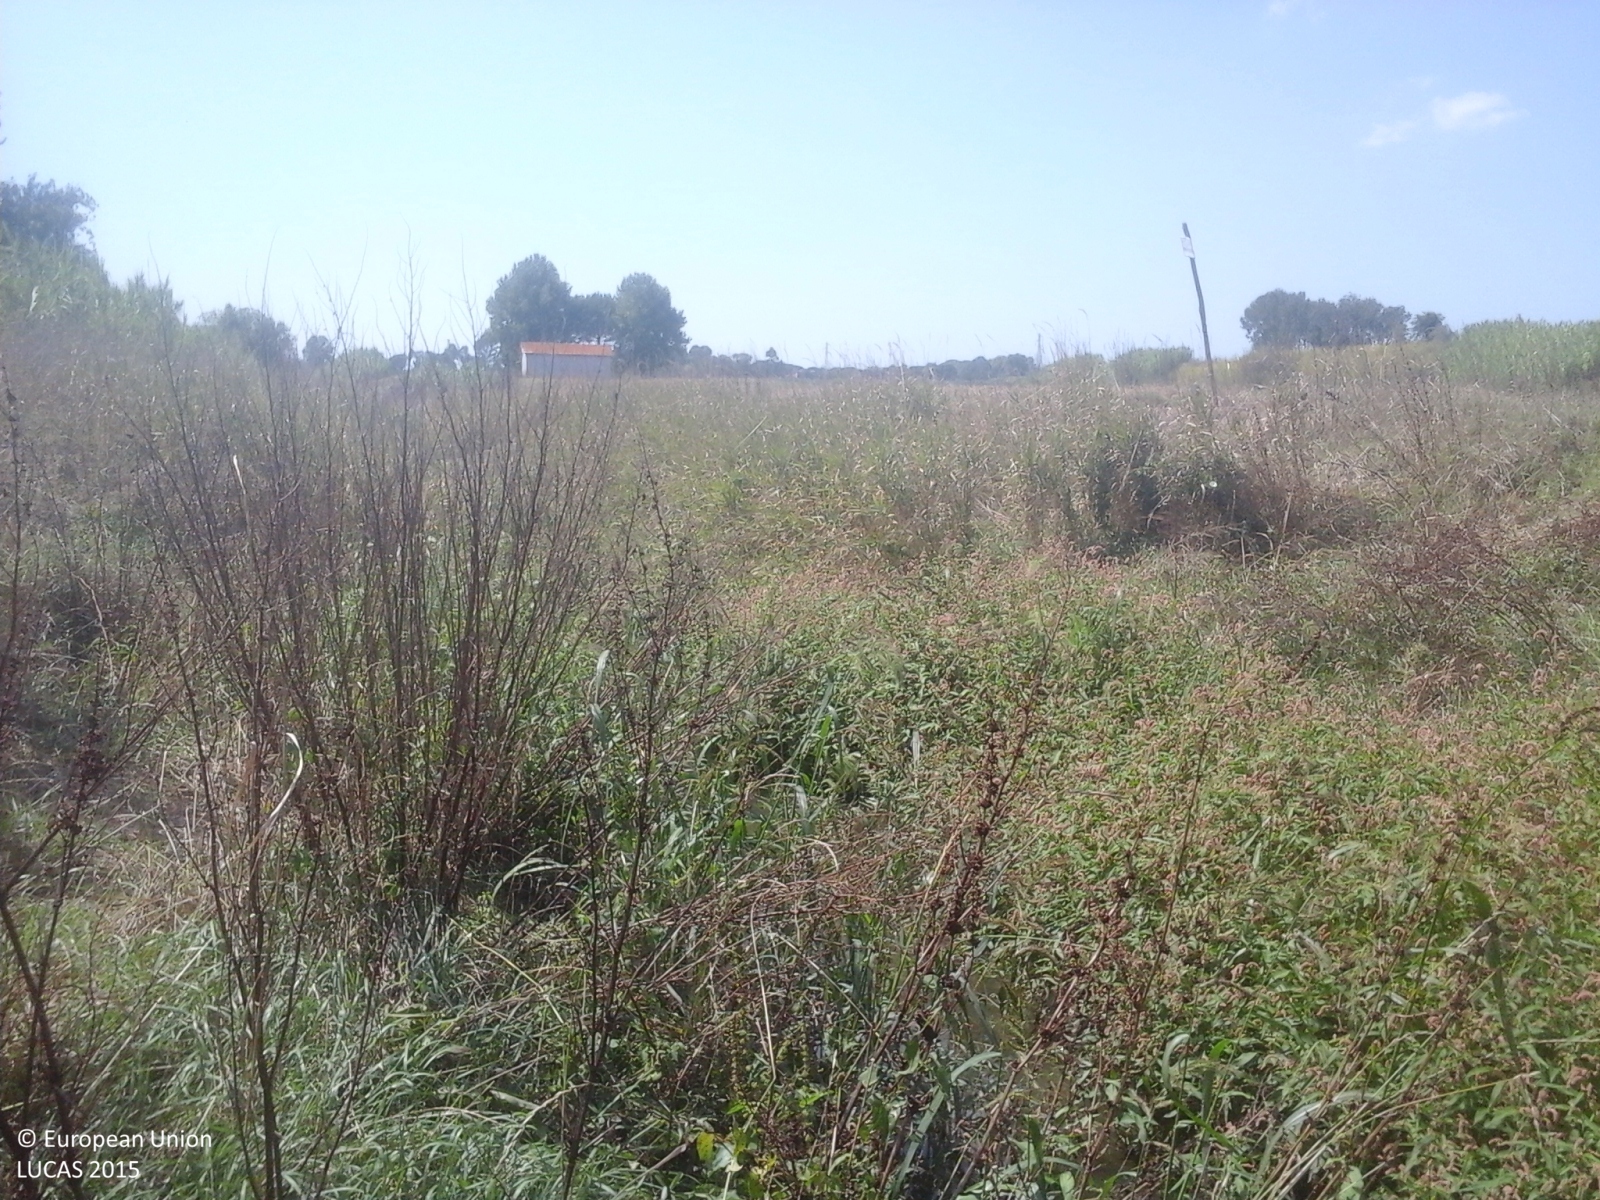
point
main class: Cropland
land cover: Temporary grasslands
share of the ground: > 75 %
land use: Agriculture (excluding fallow land and kitchen gardens)
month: August
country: IT
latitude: 43.6277
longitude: 10.5068
